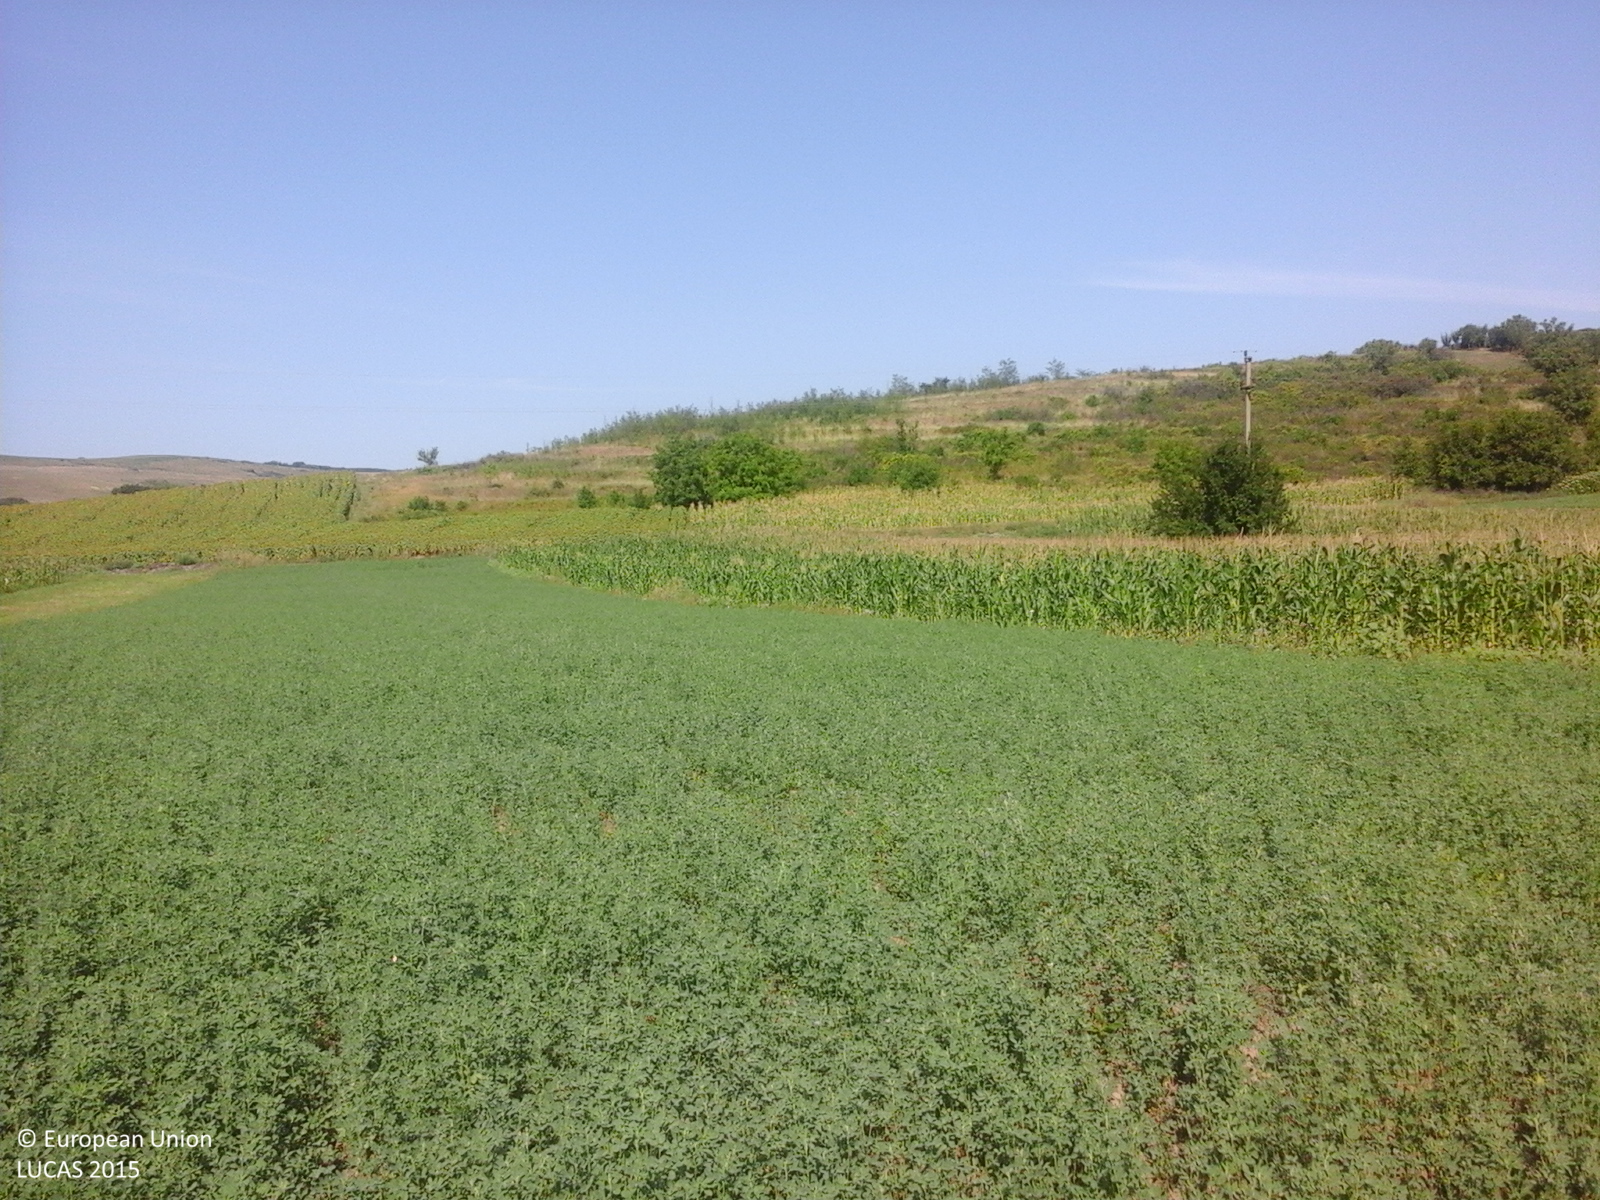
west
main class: Cropland
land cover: Lucerne
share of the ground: > 75 %
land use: Agriculture (excluding fallow land and kitchen gardens)
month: July
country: RO
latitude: 46.1979
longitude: 27.2984
